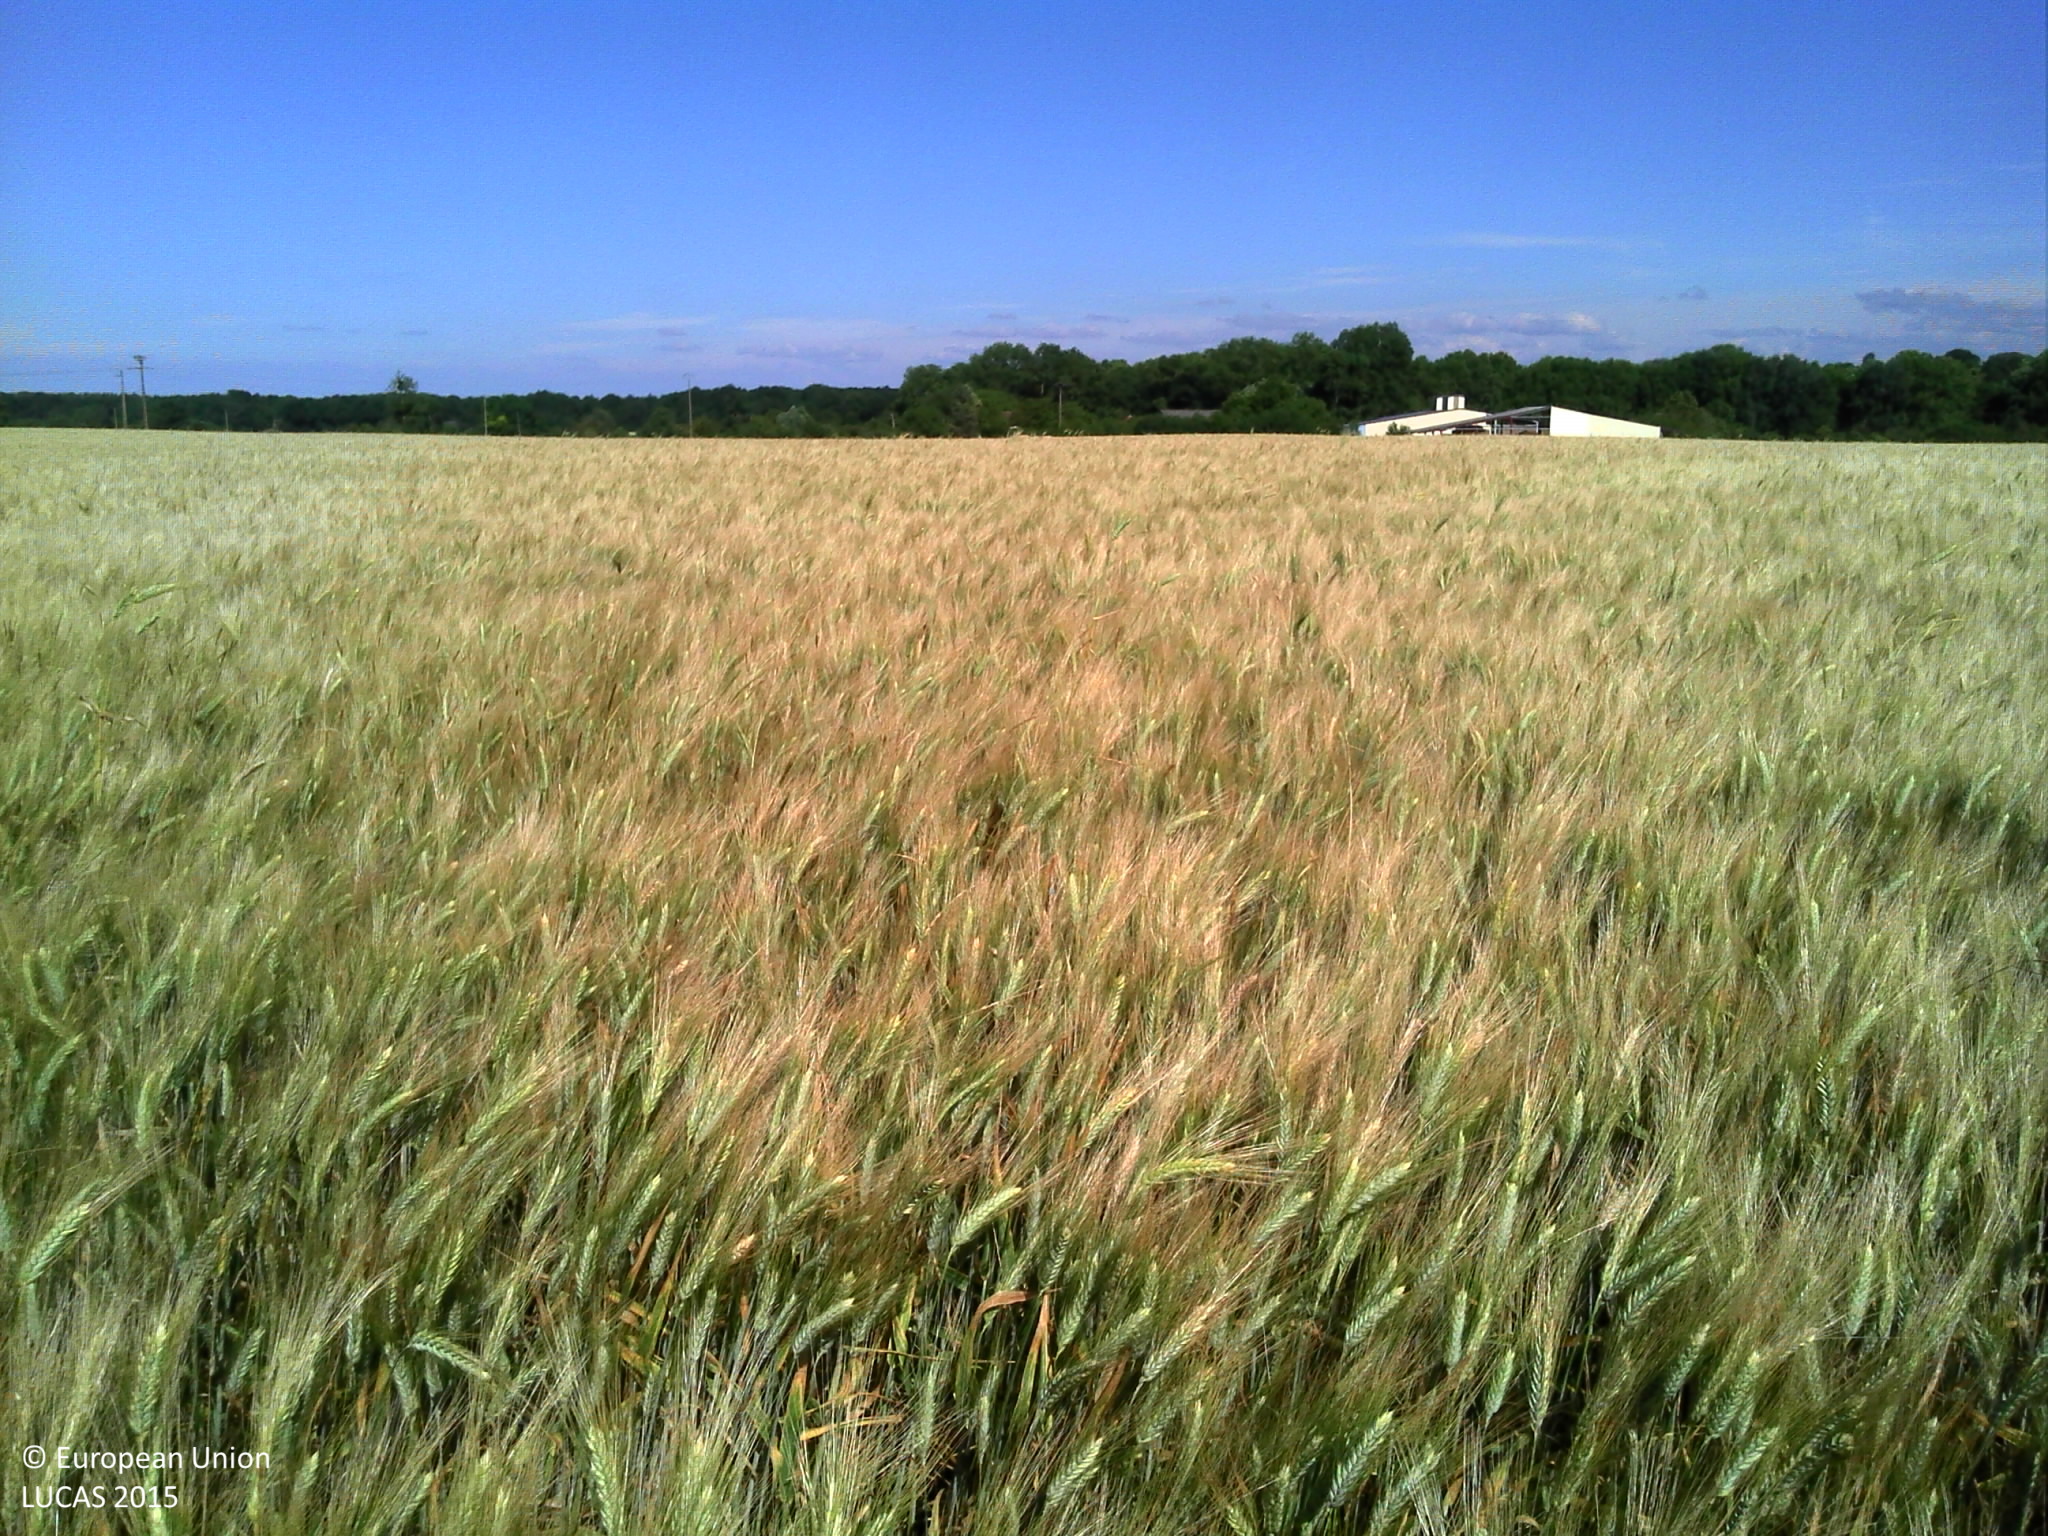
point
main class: Cropland
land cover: Barley
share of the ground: > 75 %
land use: Agriculture (excluding fallow land and kitchen gardens)
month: June
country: FR
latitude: 46.8191
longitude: 0.1347
